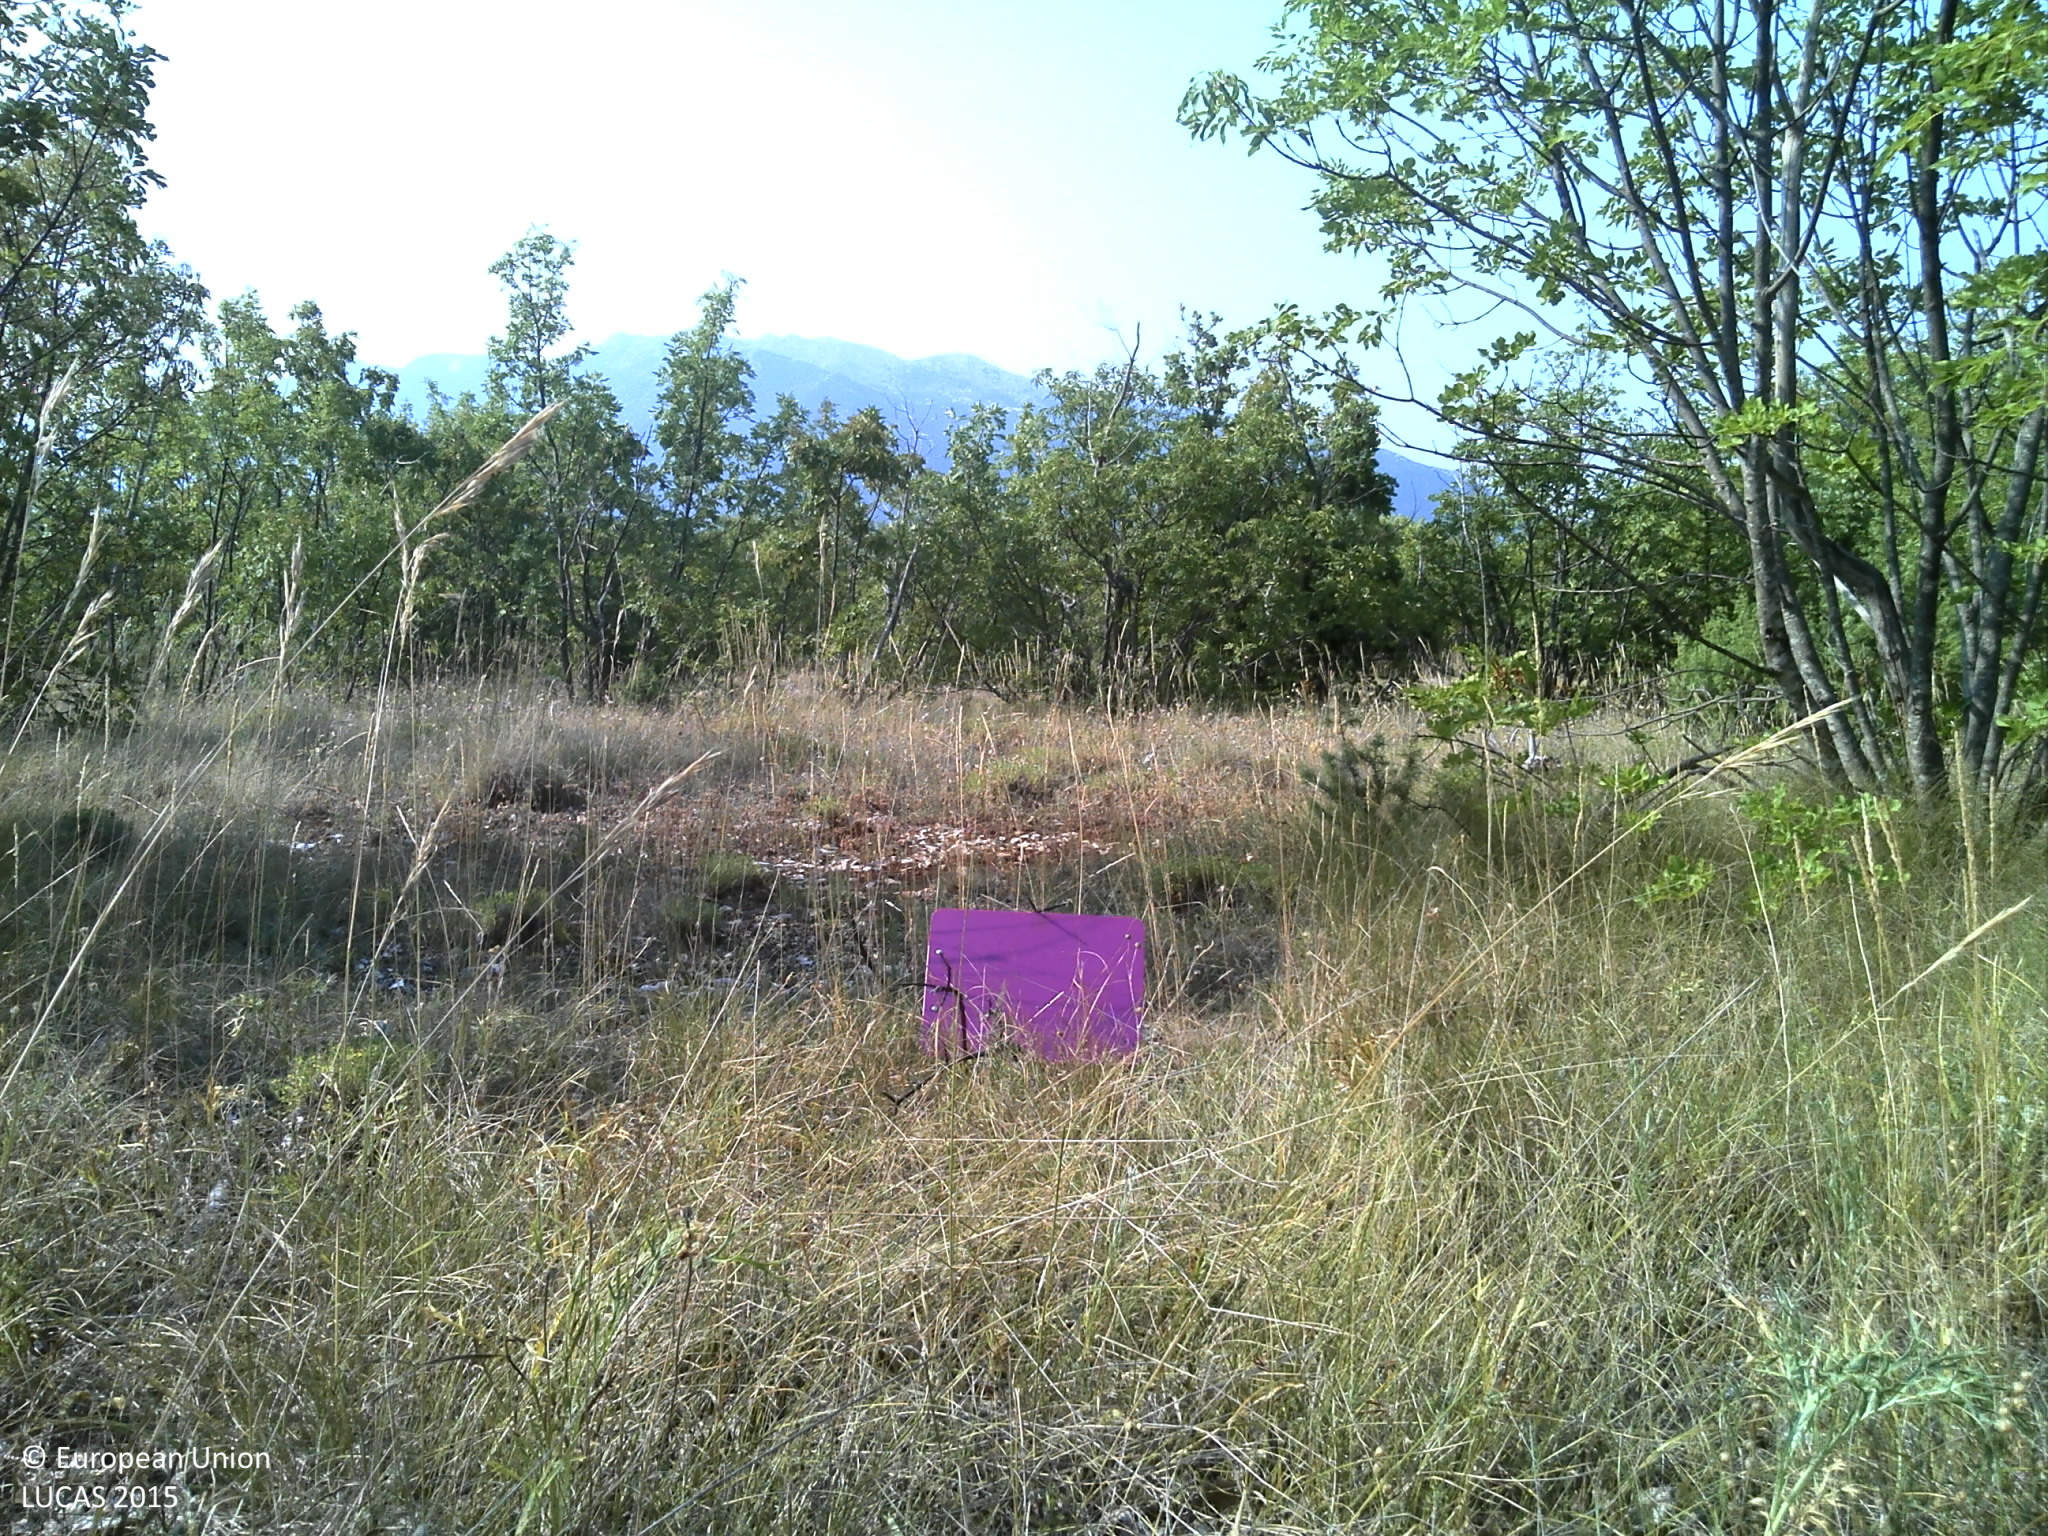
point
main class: Shrubland
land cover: Shrubland with sparse tree cover
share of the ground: > 75 %
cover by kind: shrubs 70 %, herbaceous plants 15 %, broadleaved forest trees 5 %, lichens and mosses 5 %, consolidated bare surface 5 %
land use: Semi-natural and natural areas not in use
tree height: > 5 m
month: July
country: HR
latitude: 43.4657
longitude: 16.9504
